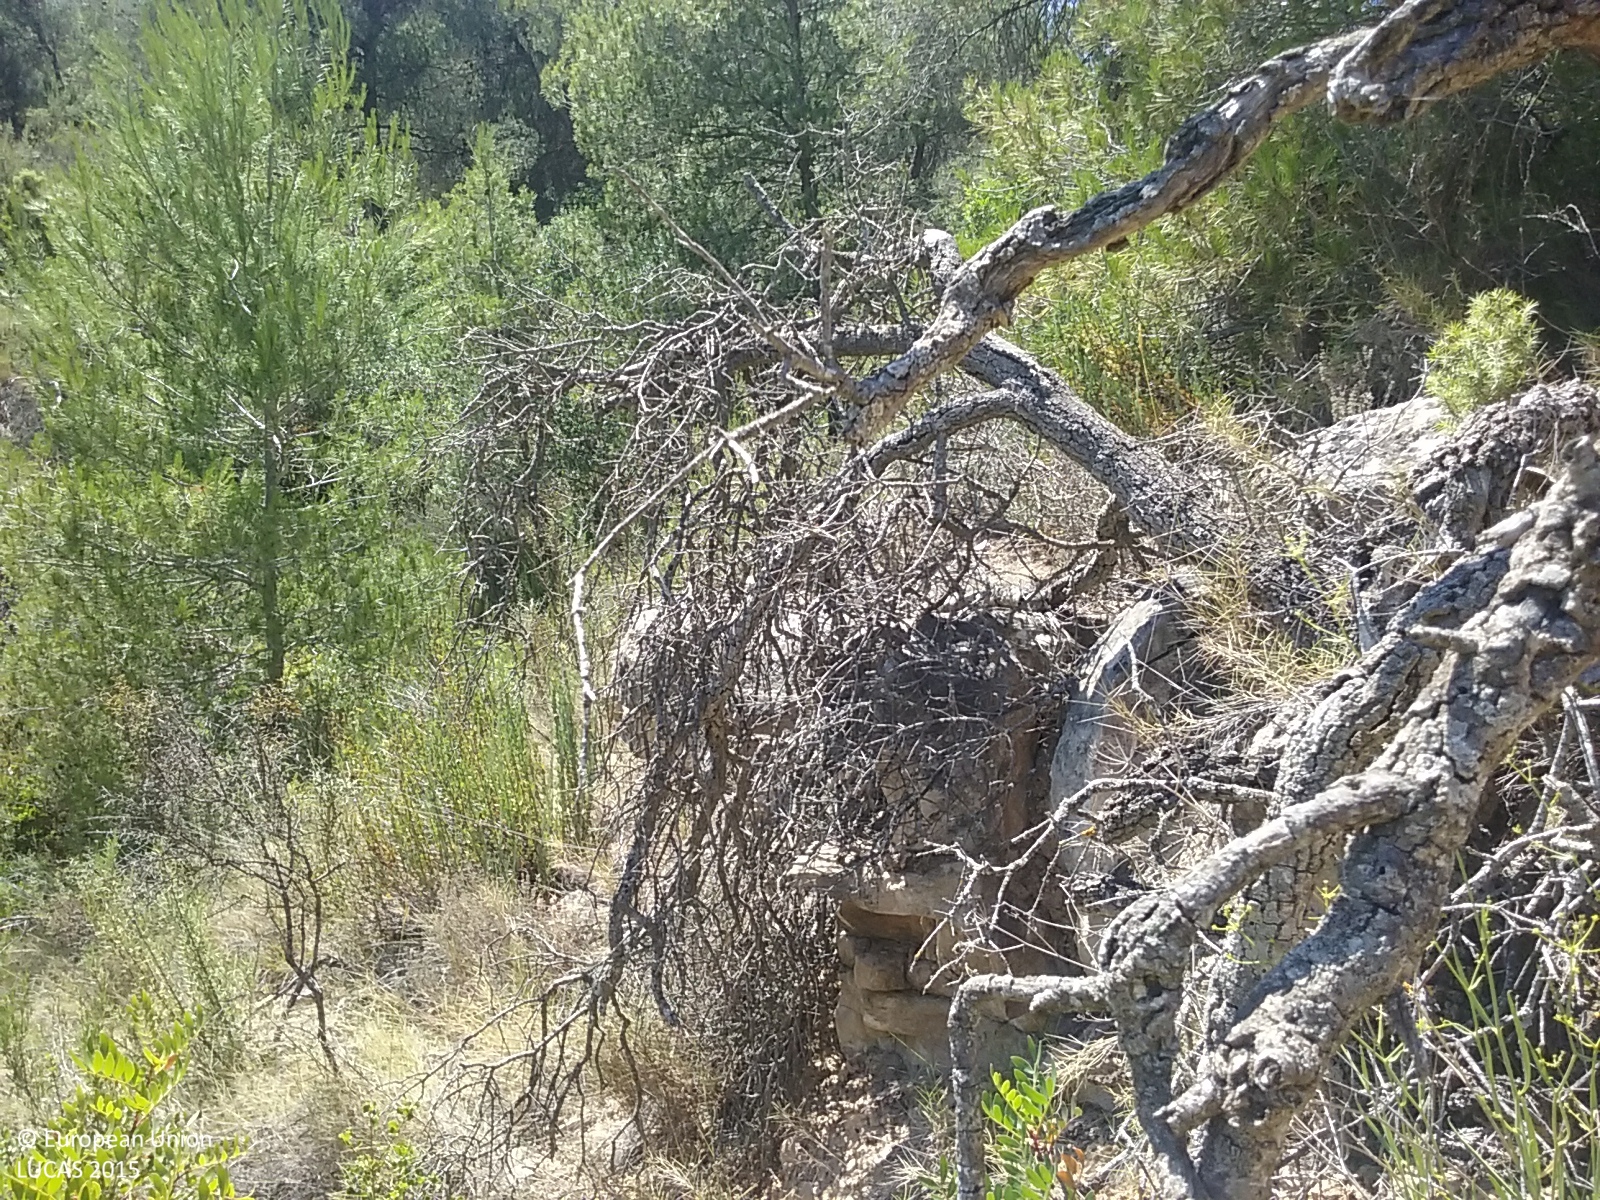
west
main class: Woodland
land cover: Pine dominated coniferous woodland
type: coniferous forest of the mediterranean region
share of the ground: 10 - 25 %
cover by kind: shrubs 75 %, coniferous forest trees 25 %
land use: Semi-natural and natural areas not in use
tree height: > 5 m
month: June
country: ES
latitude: 41.3128
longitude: 0.4691
